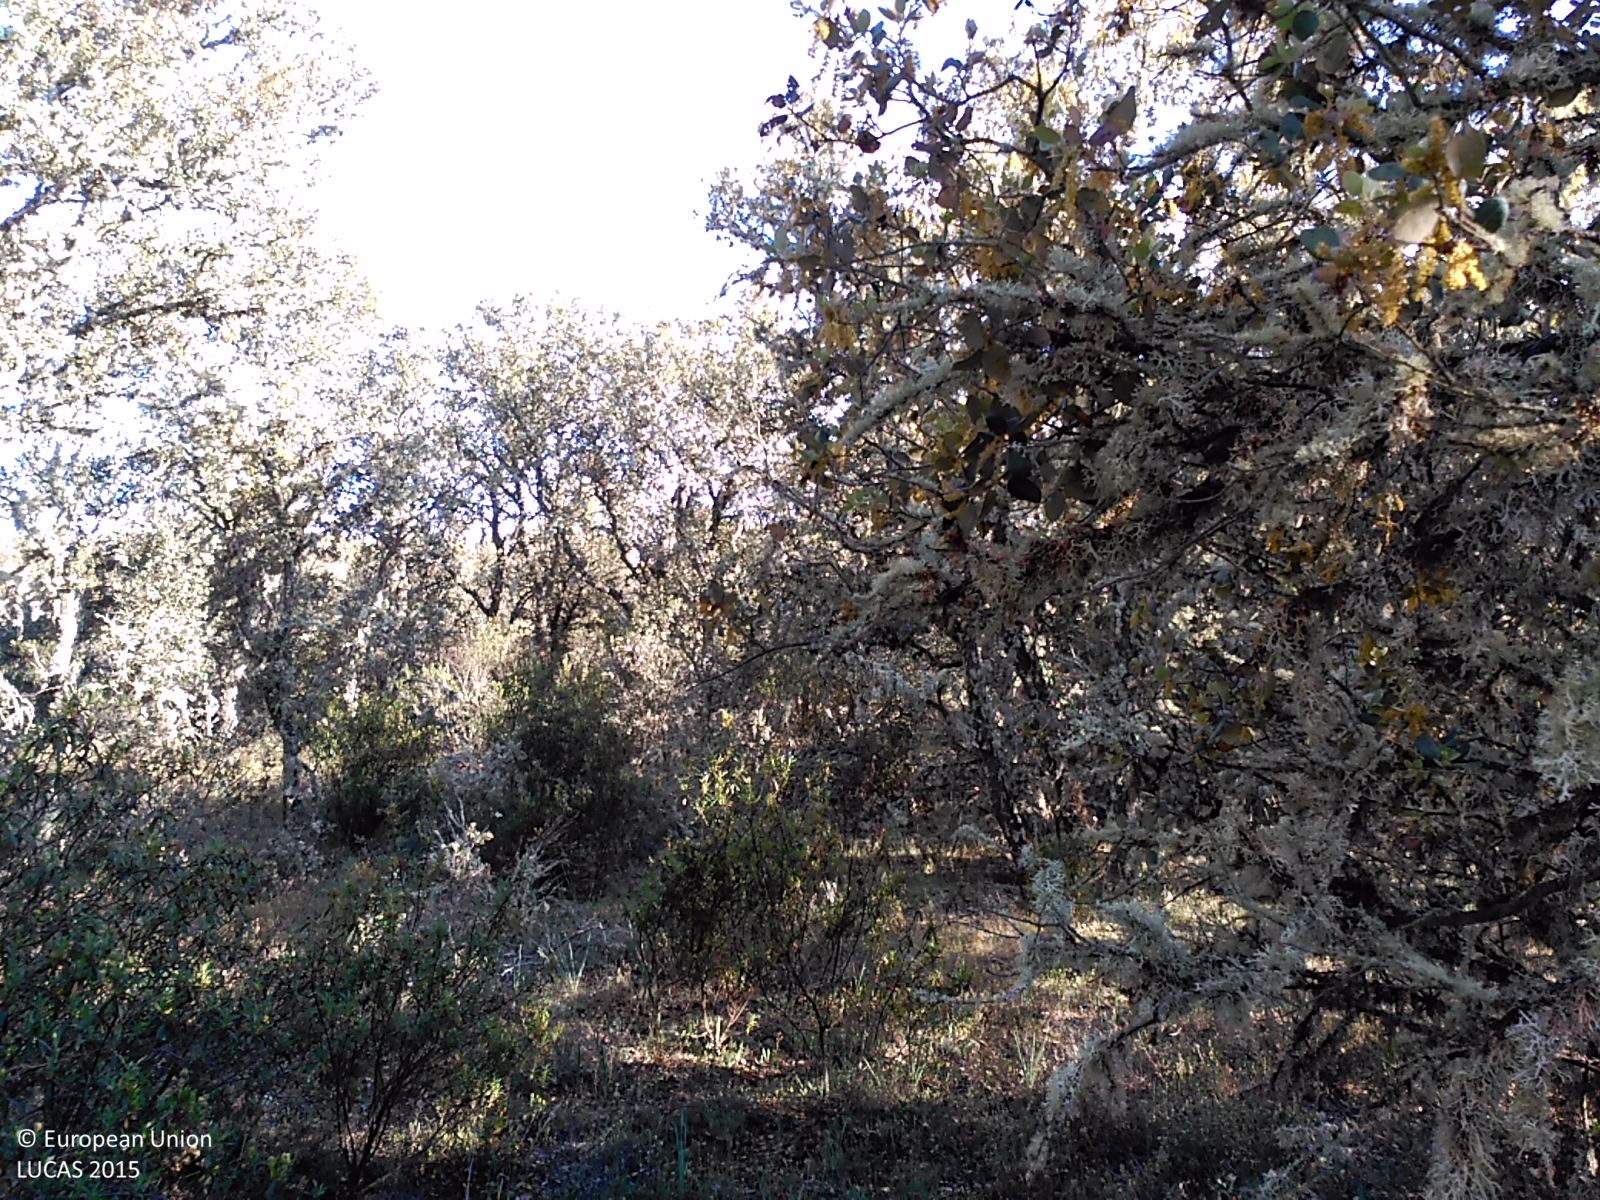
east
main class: Woodland
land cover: Broadleaved woodland
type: broadleaved evergreen forest
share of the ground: > 75 %
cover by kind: broadleaved forest trees 90 %, shrubs 10 %
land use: Forestry
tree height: > 5 m
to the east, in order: Broadleaved woodland; Shrubland with sparse tree cover; Tracks
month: May
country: ES
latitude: 42.0228
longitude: -5.9552
